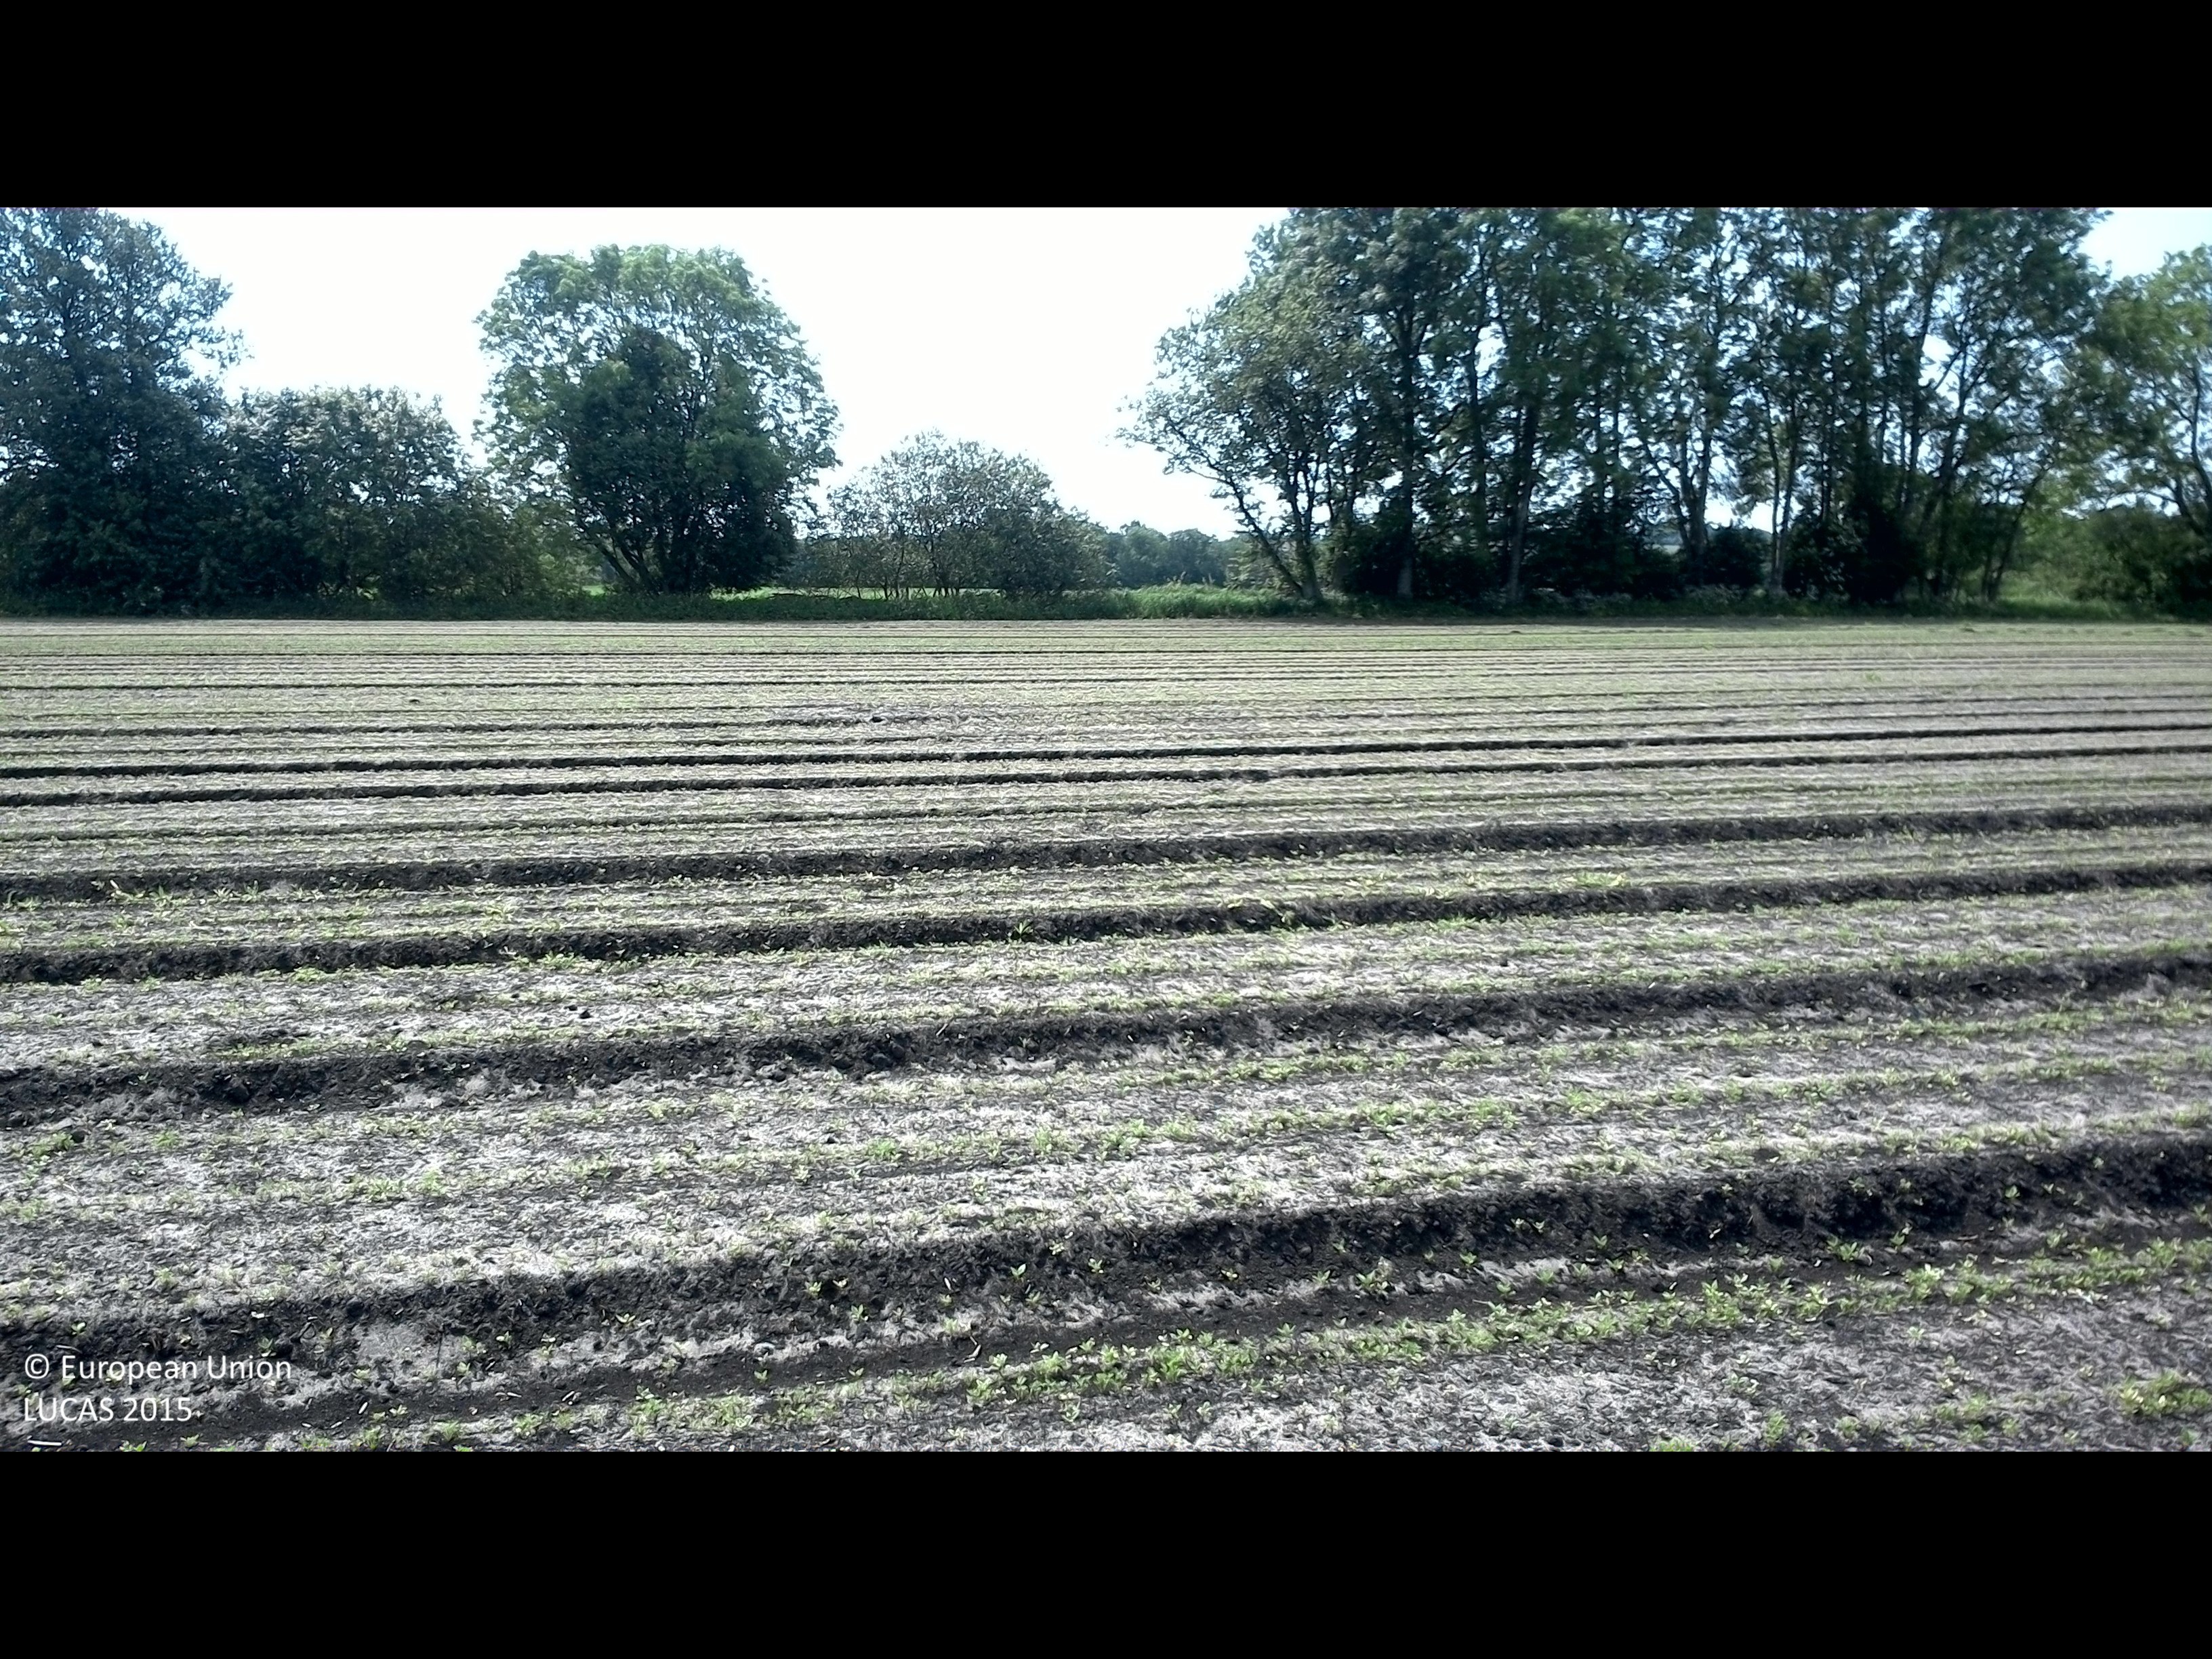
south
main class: Cropland
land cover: Other root crops
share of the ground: 10 - 25 %
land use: Agriculture (excluding fallow land and kitchen gardens)
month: June
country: SE
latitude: 55.8143
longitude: 14.1633
